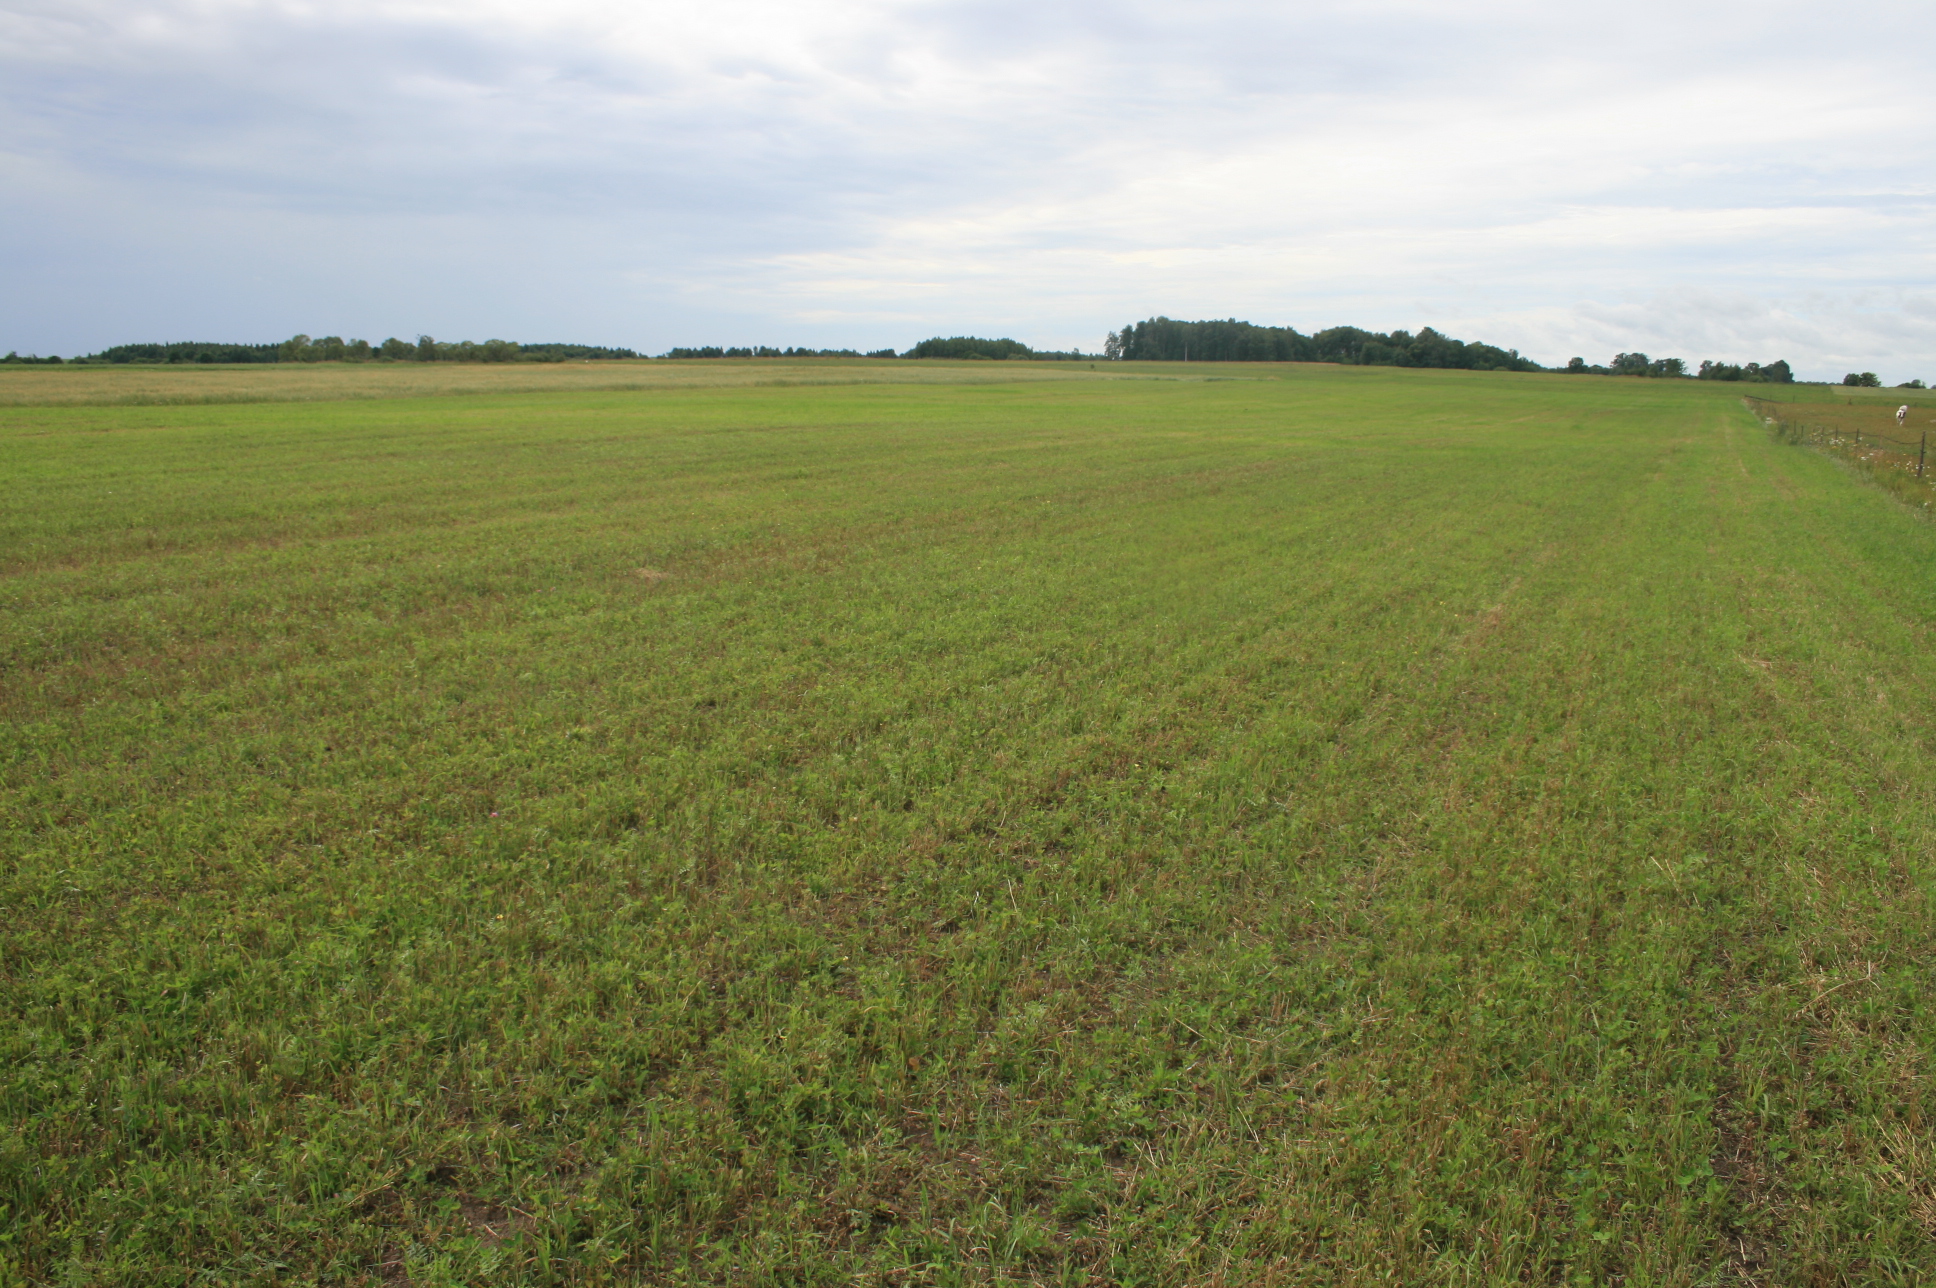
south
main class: Cropland
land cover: Other leguminous and mixtures for fodder
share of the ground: > 75 %
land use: Agriculture (excluding fallow land and kitchen gardens)
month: July
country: LT
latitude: 55.2940
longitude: 22.0069
